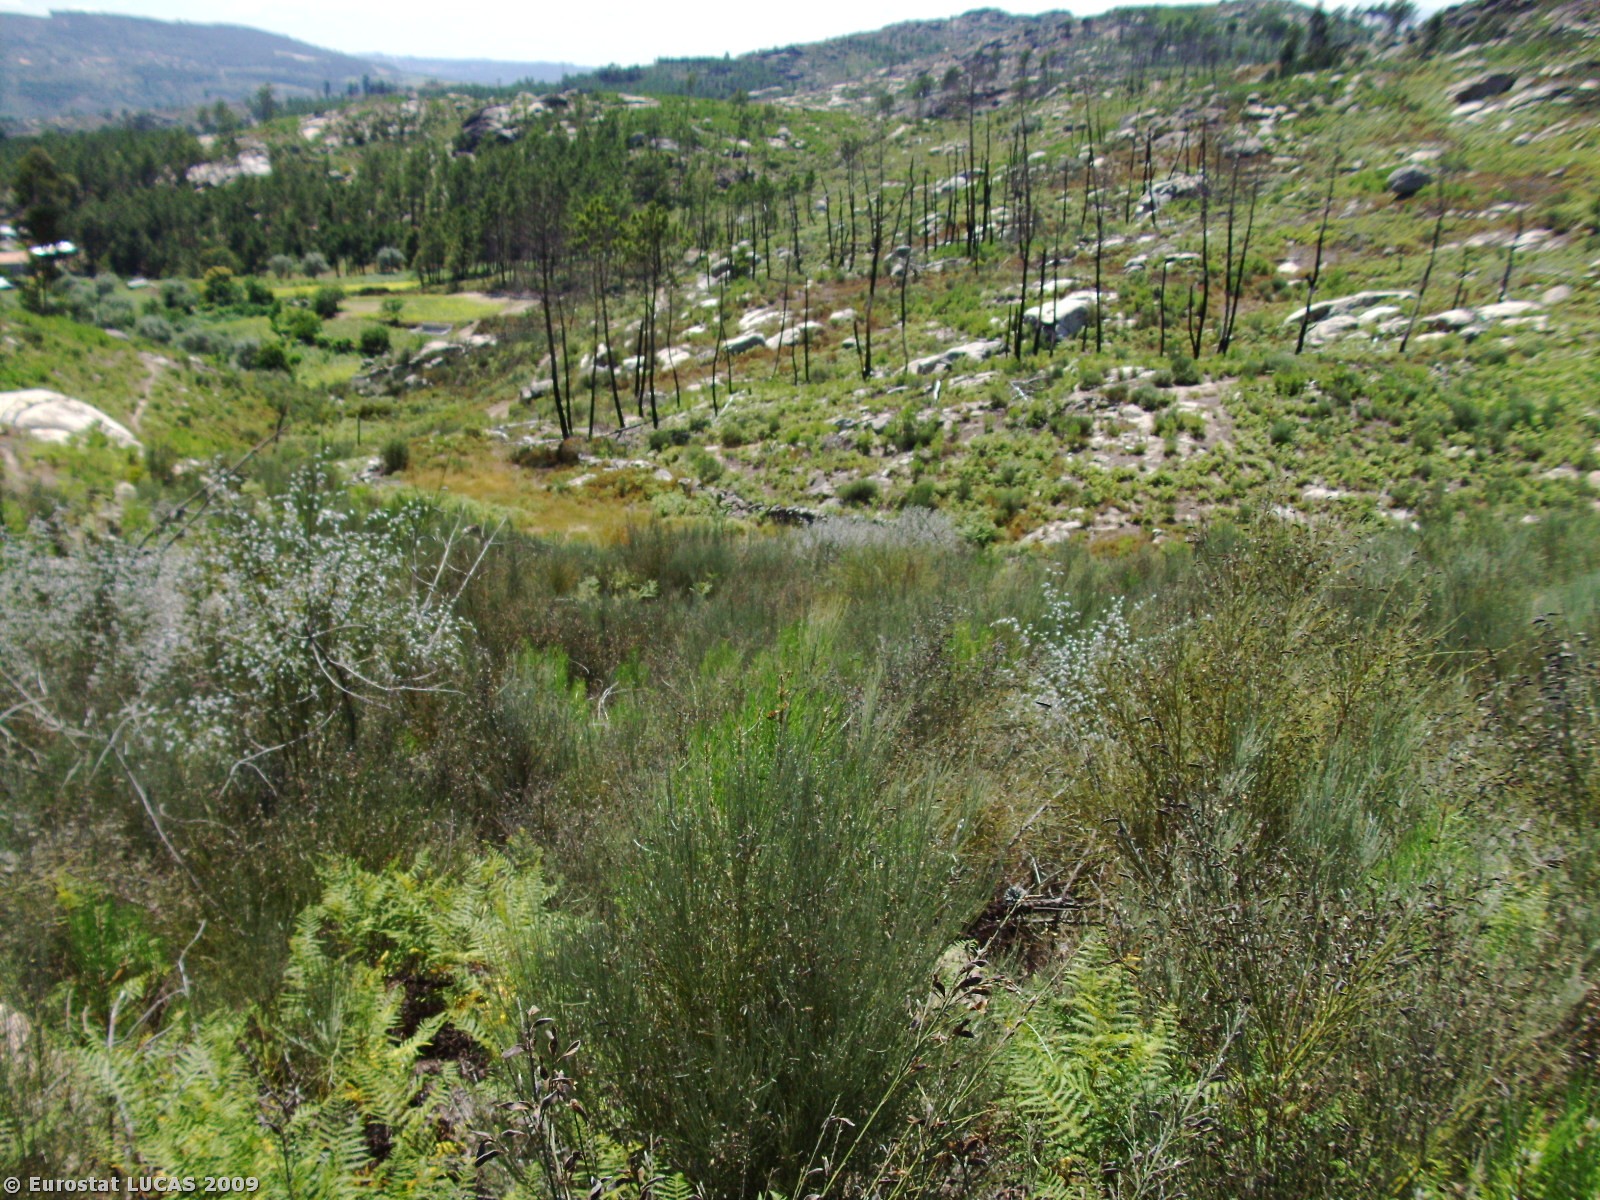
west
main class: Shrubland
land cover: Shrubland without tree cover
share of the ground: 50 - 75 %
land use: Unused
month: July
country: PT
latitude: 40.6851
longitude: -7.6414
